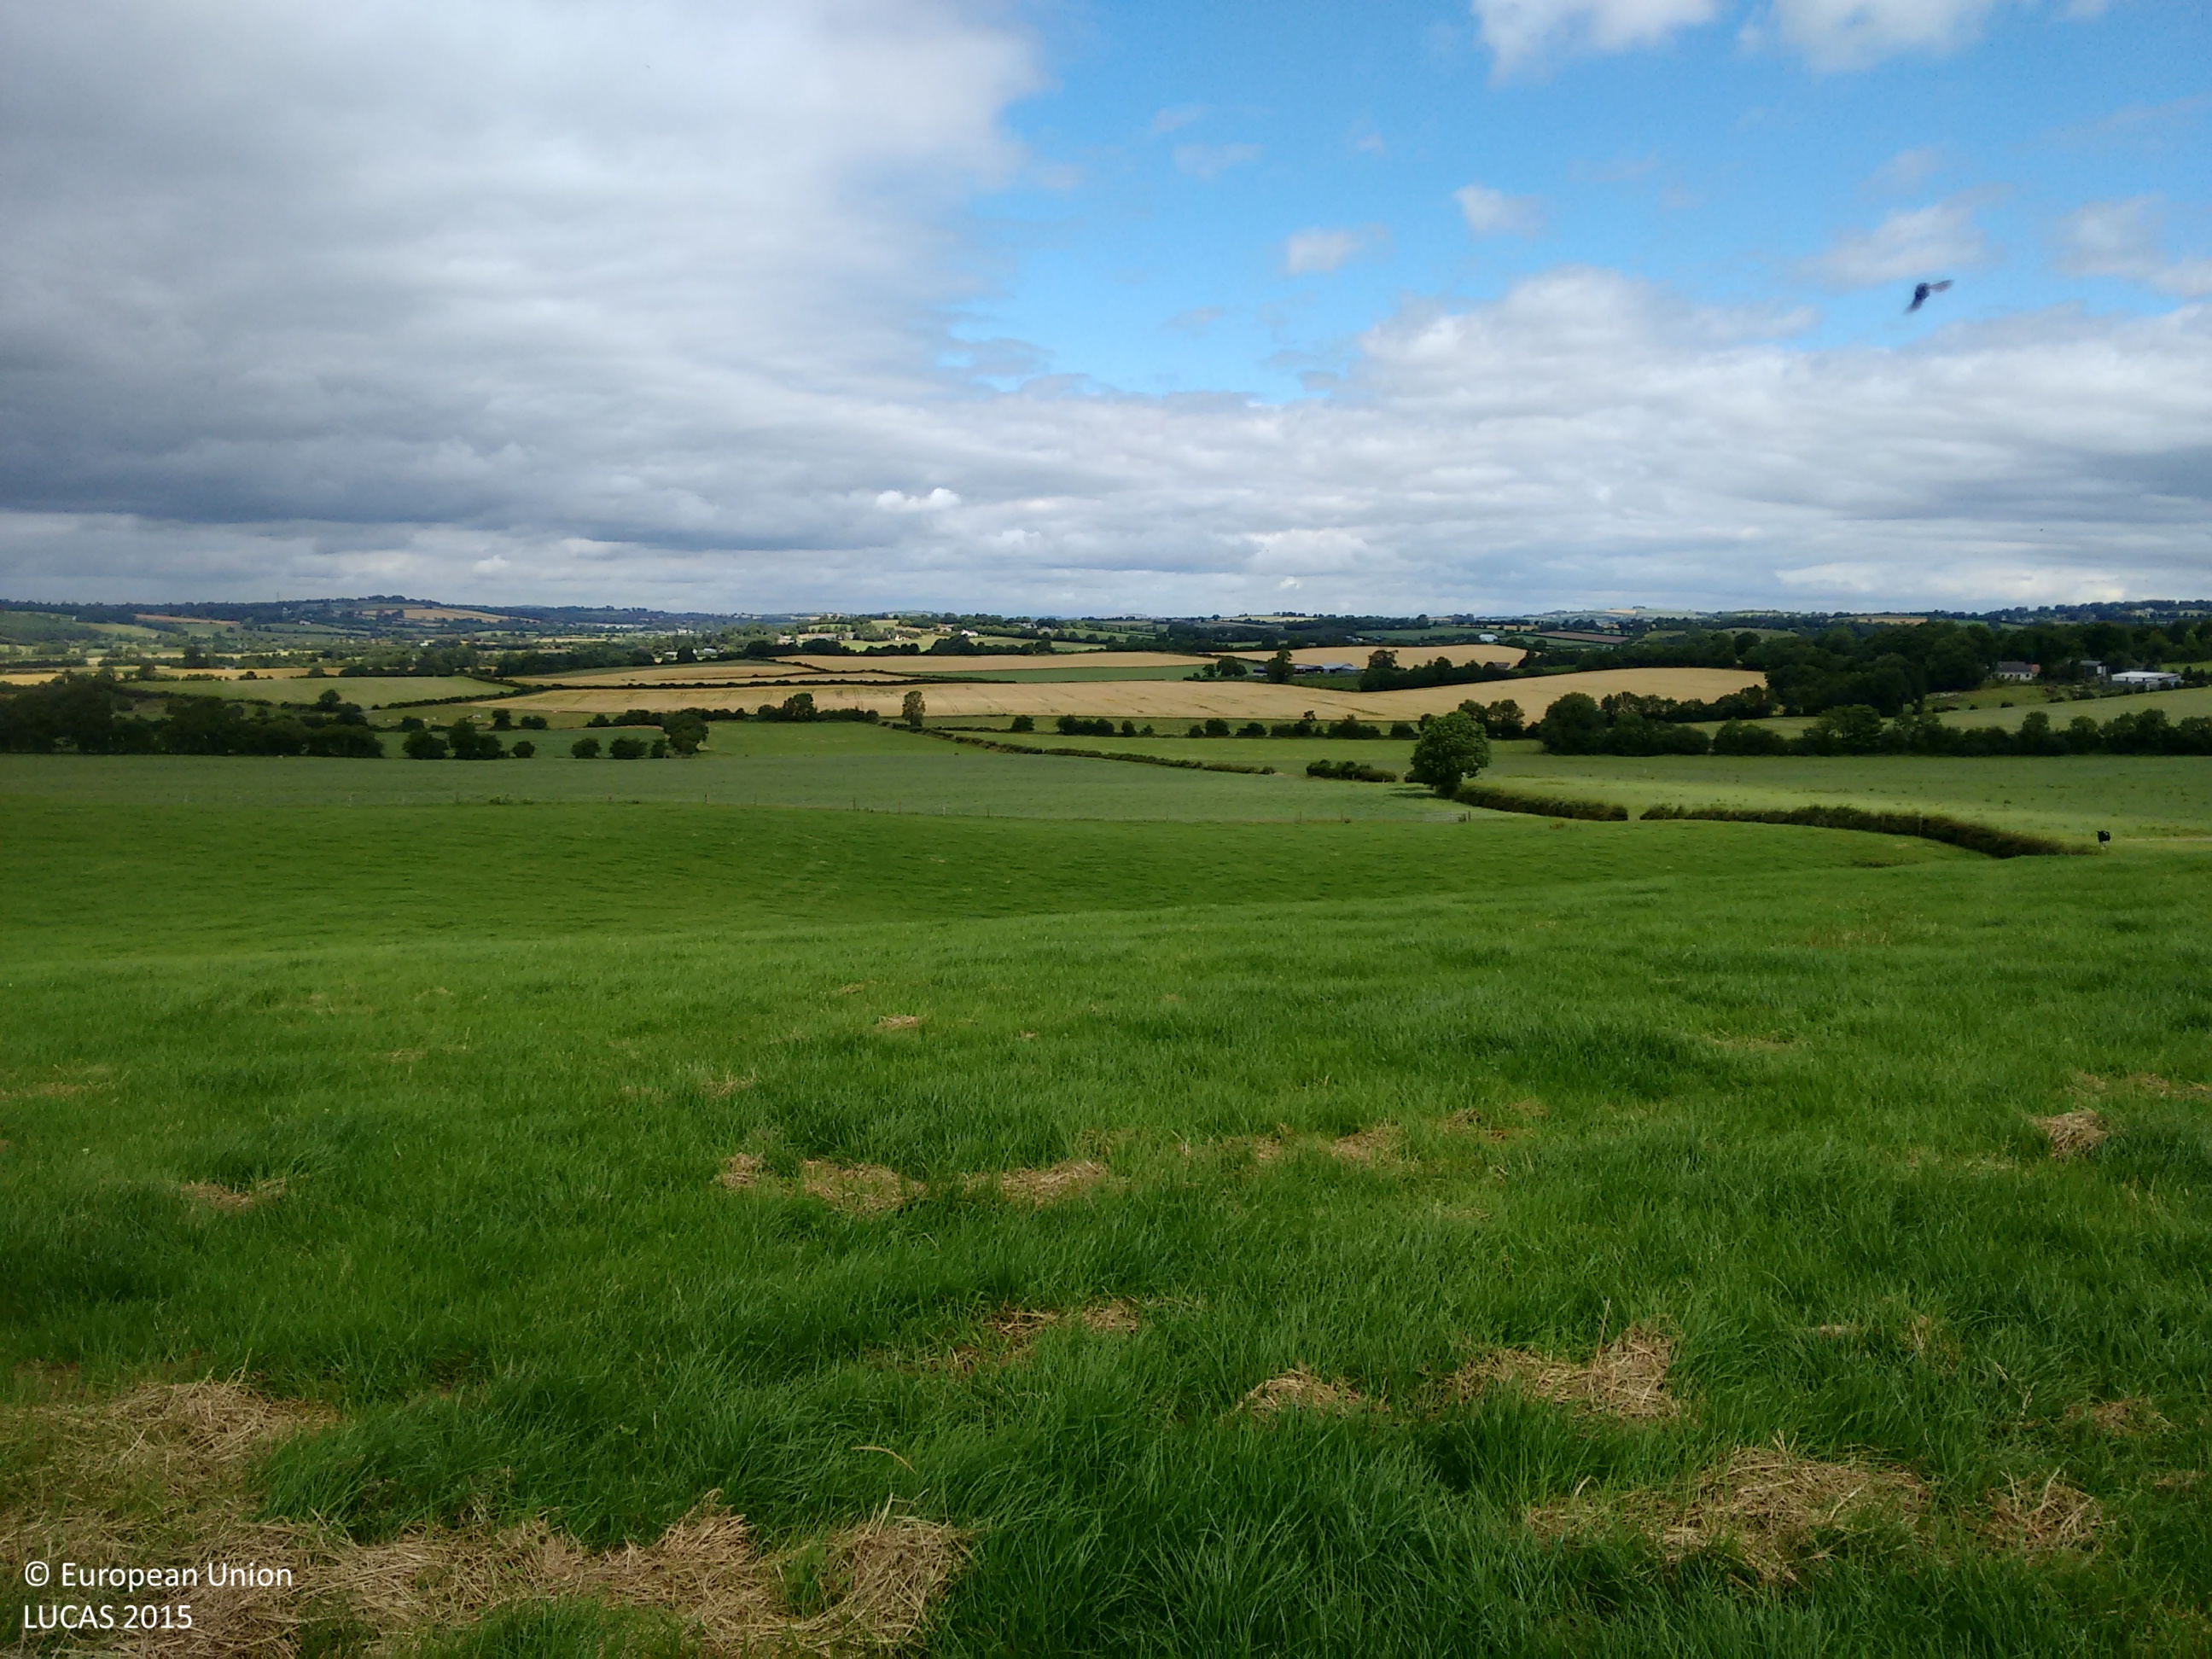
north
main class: Grassland
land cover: Grassland without tree/shrub cover
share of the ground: > 75 %
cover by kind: herbaceous plants 100 %
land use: Agriculture (excluding fallow land and kitchen gardens)
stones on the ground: < 10 %
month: July
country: IE
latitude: 52.9700
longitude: -6.7985
